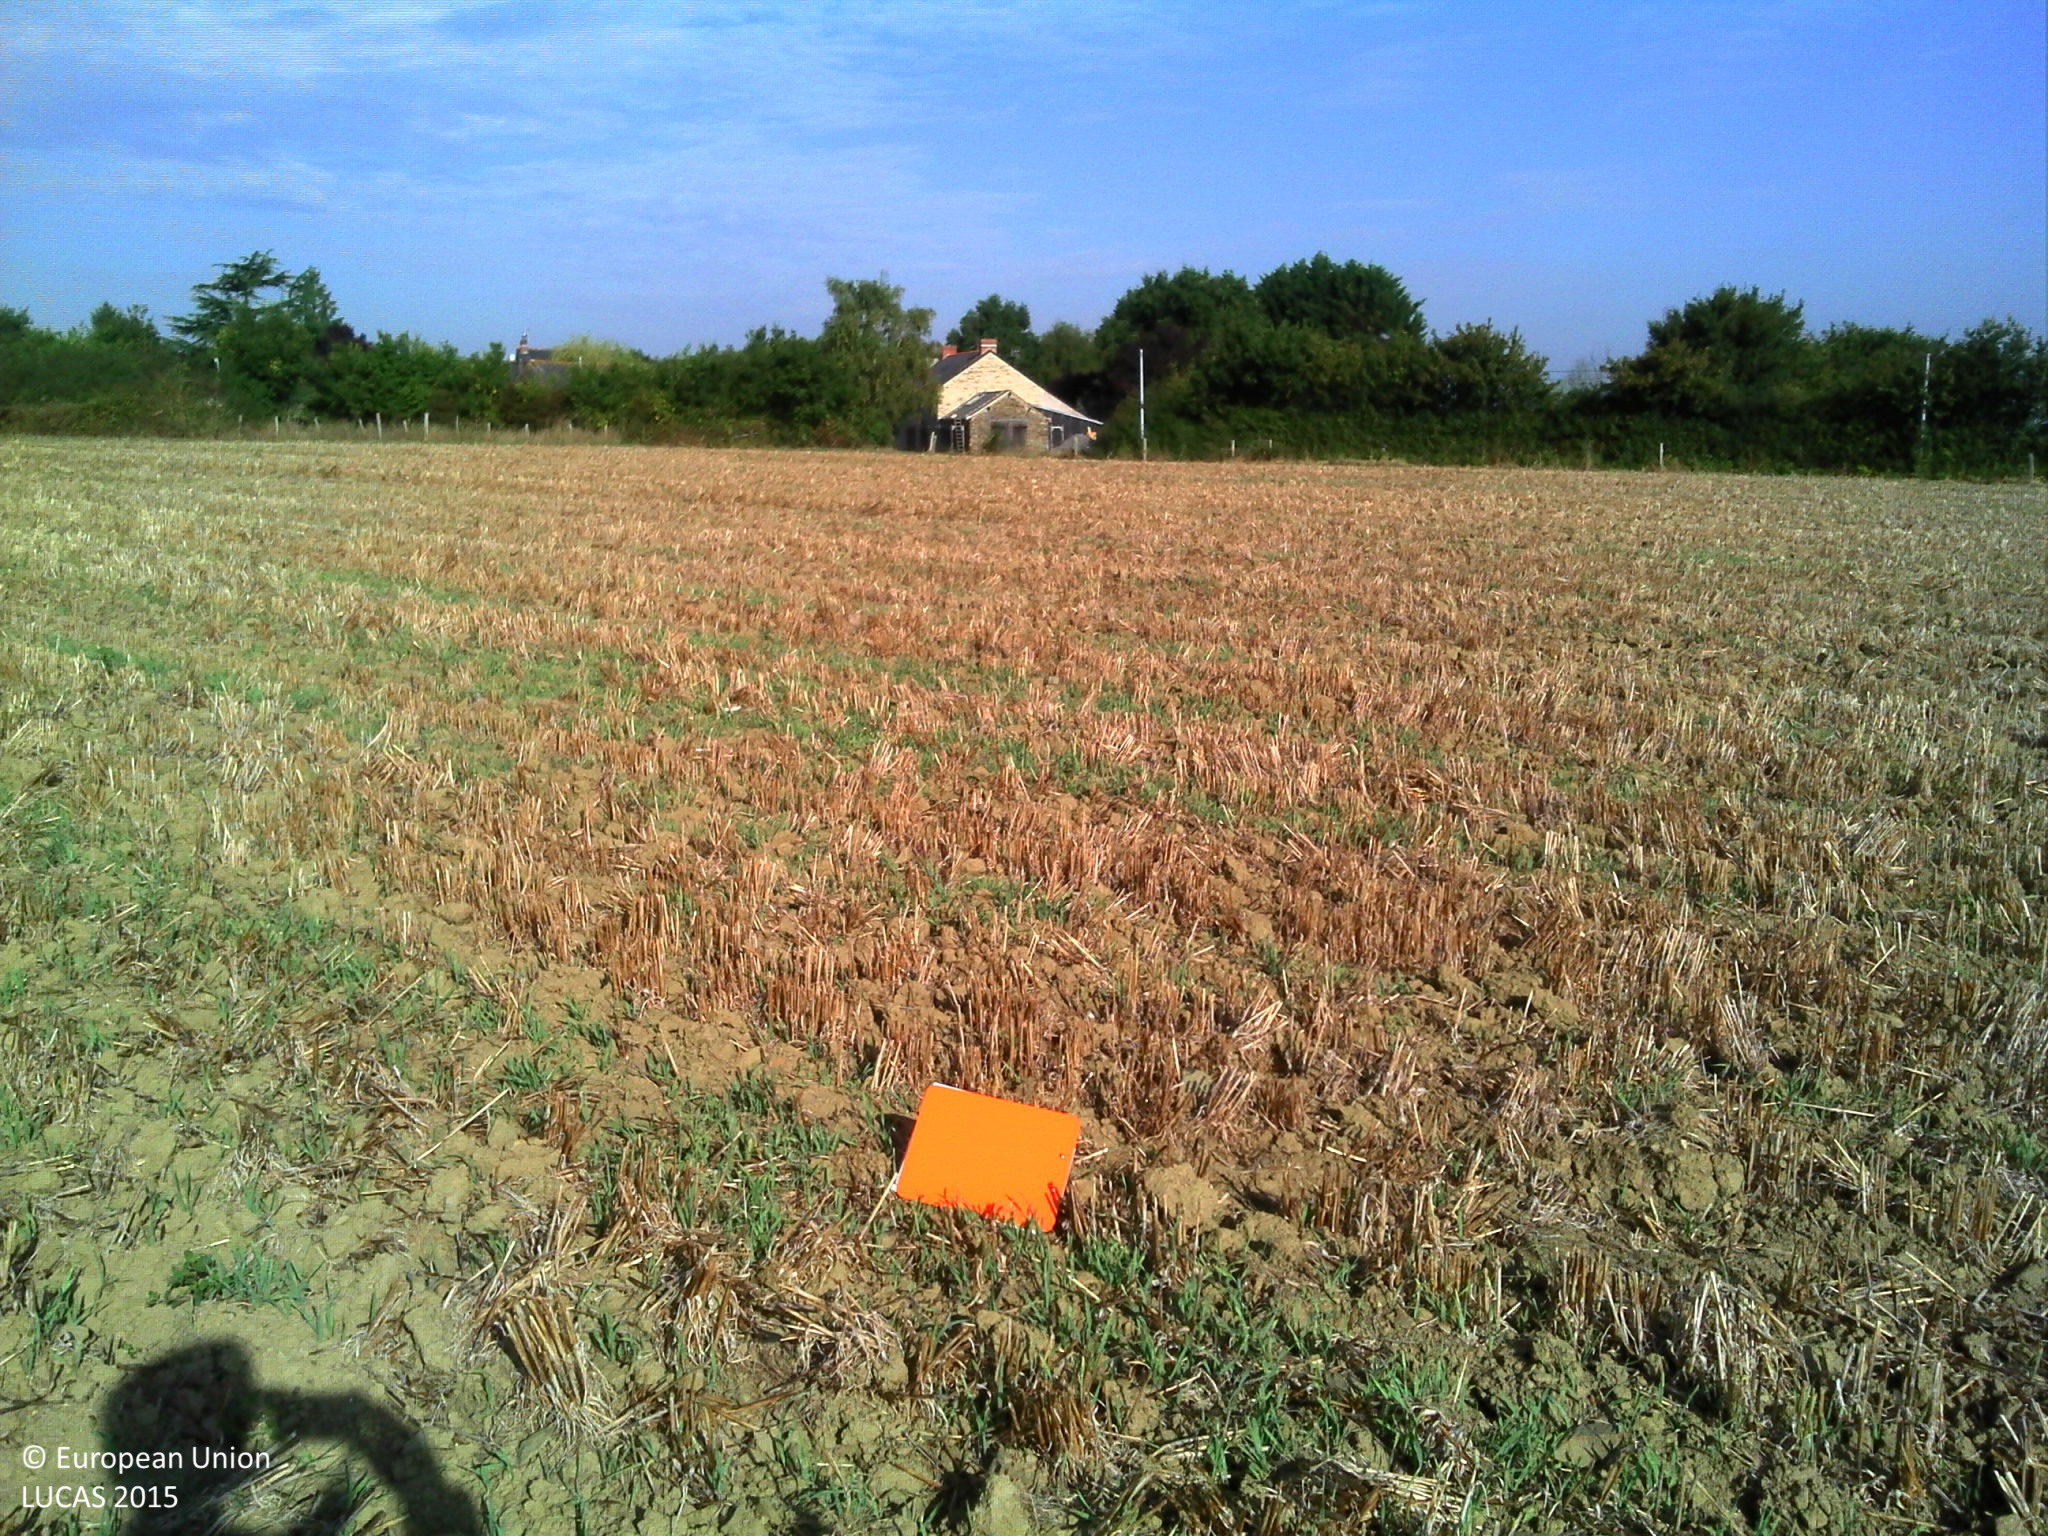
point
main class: Cropland
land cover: Barley
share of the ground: < 10 %
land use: Agriculture (excluding fallow land and kitchen gardens)
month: August
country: FR
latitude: 47.4203
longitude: -1.8307
